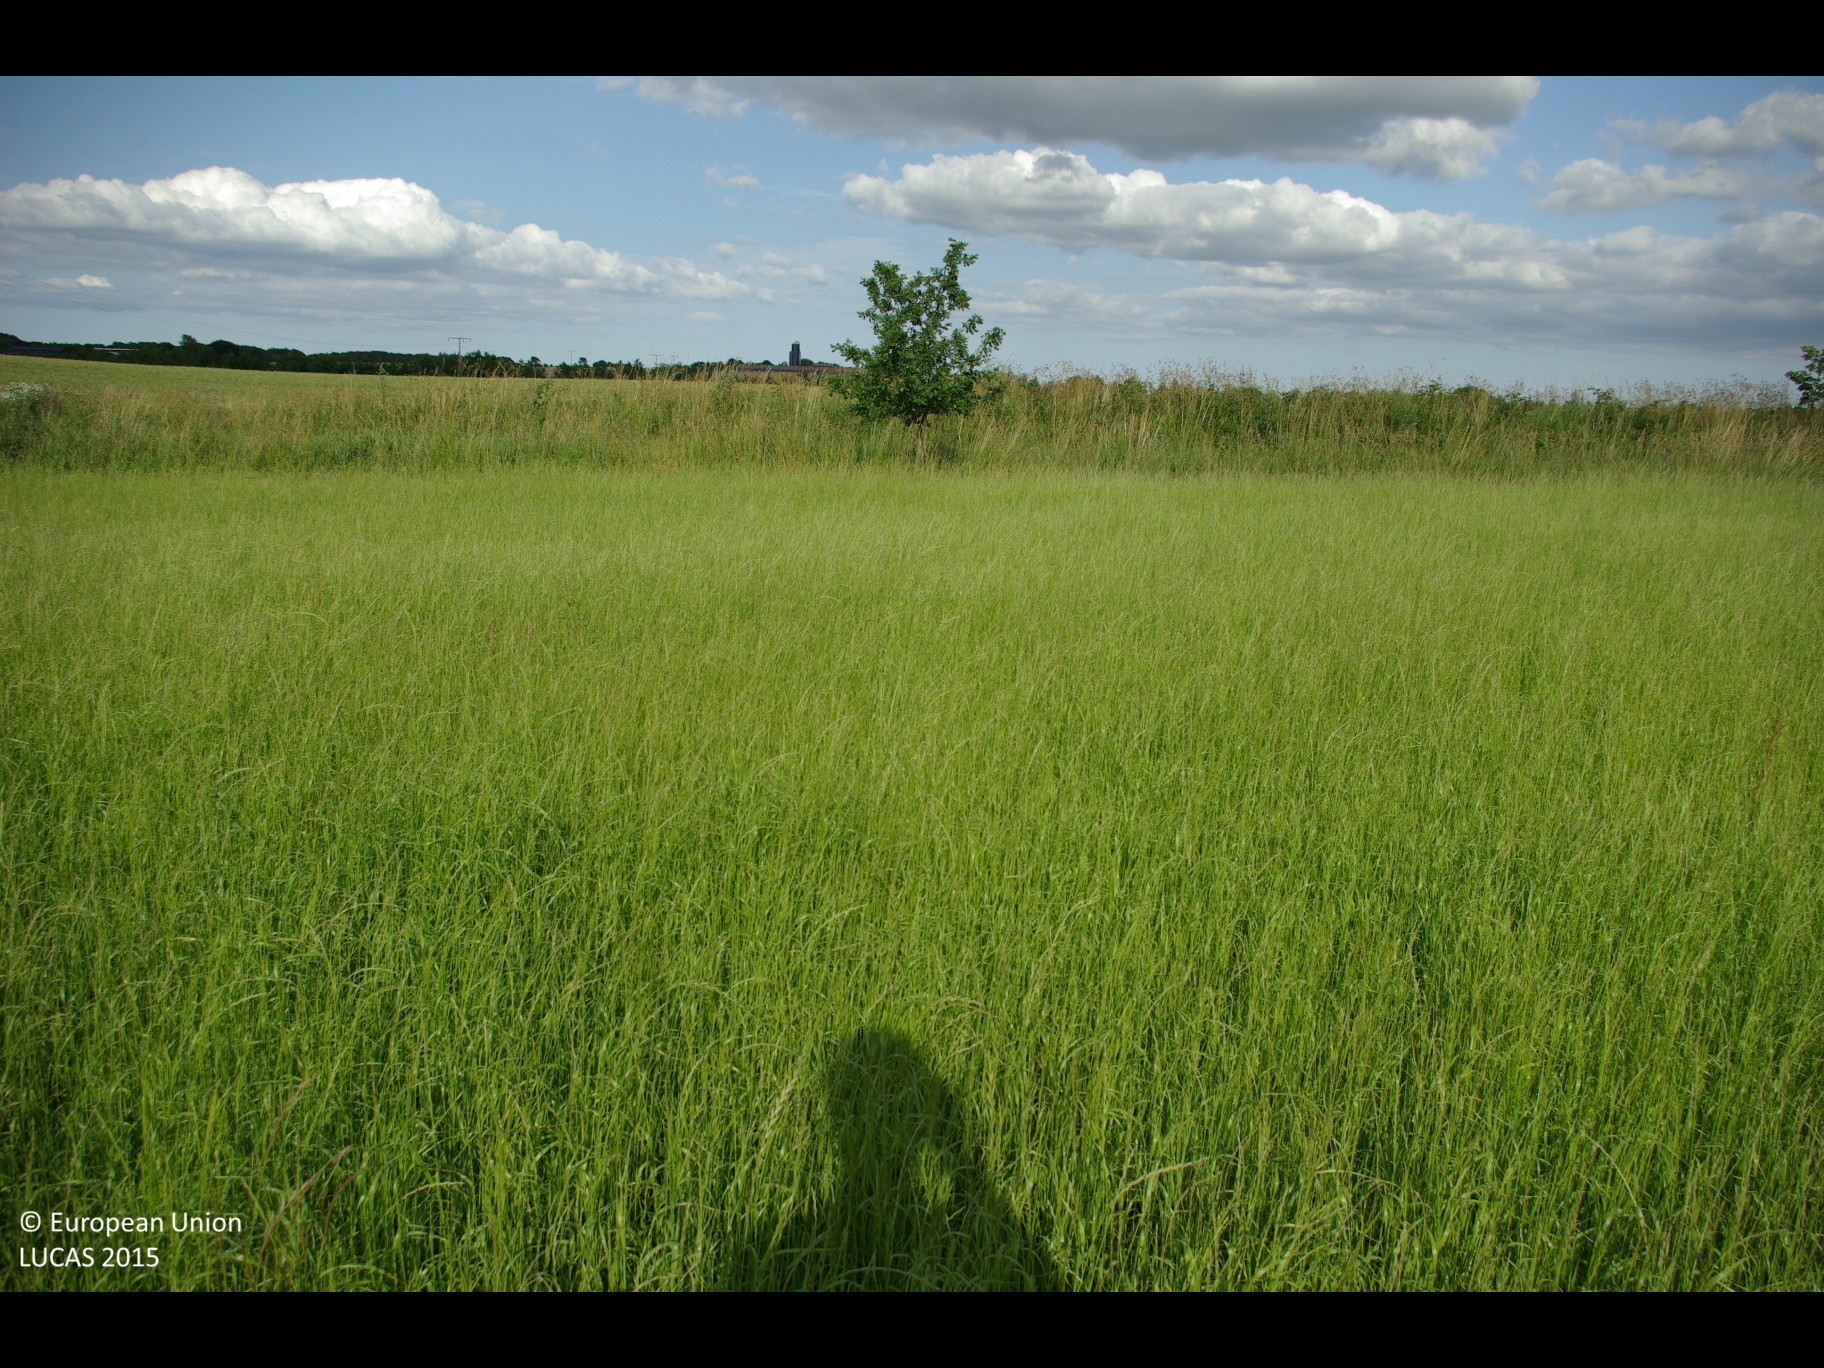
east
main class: Grassland
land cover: Grassland without tree/shrub cover
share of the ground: > 75 %
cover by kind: herbaceous plants 100 %
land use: Agriculture (excluding fallow land and kitchen gardens)
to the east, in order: Grassland without tree/shrub cover; Single bushes/trees; Shruby margins; Paved roads, cycling and walking lanes; Spontaneously vegetated surfaces; Common wheat
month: July
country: DE
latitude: 54.7850
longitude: 9.5494
